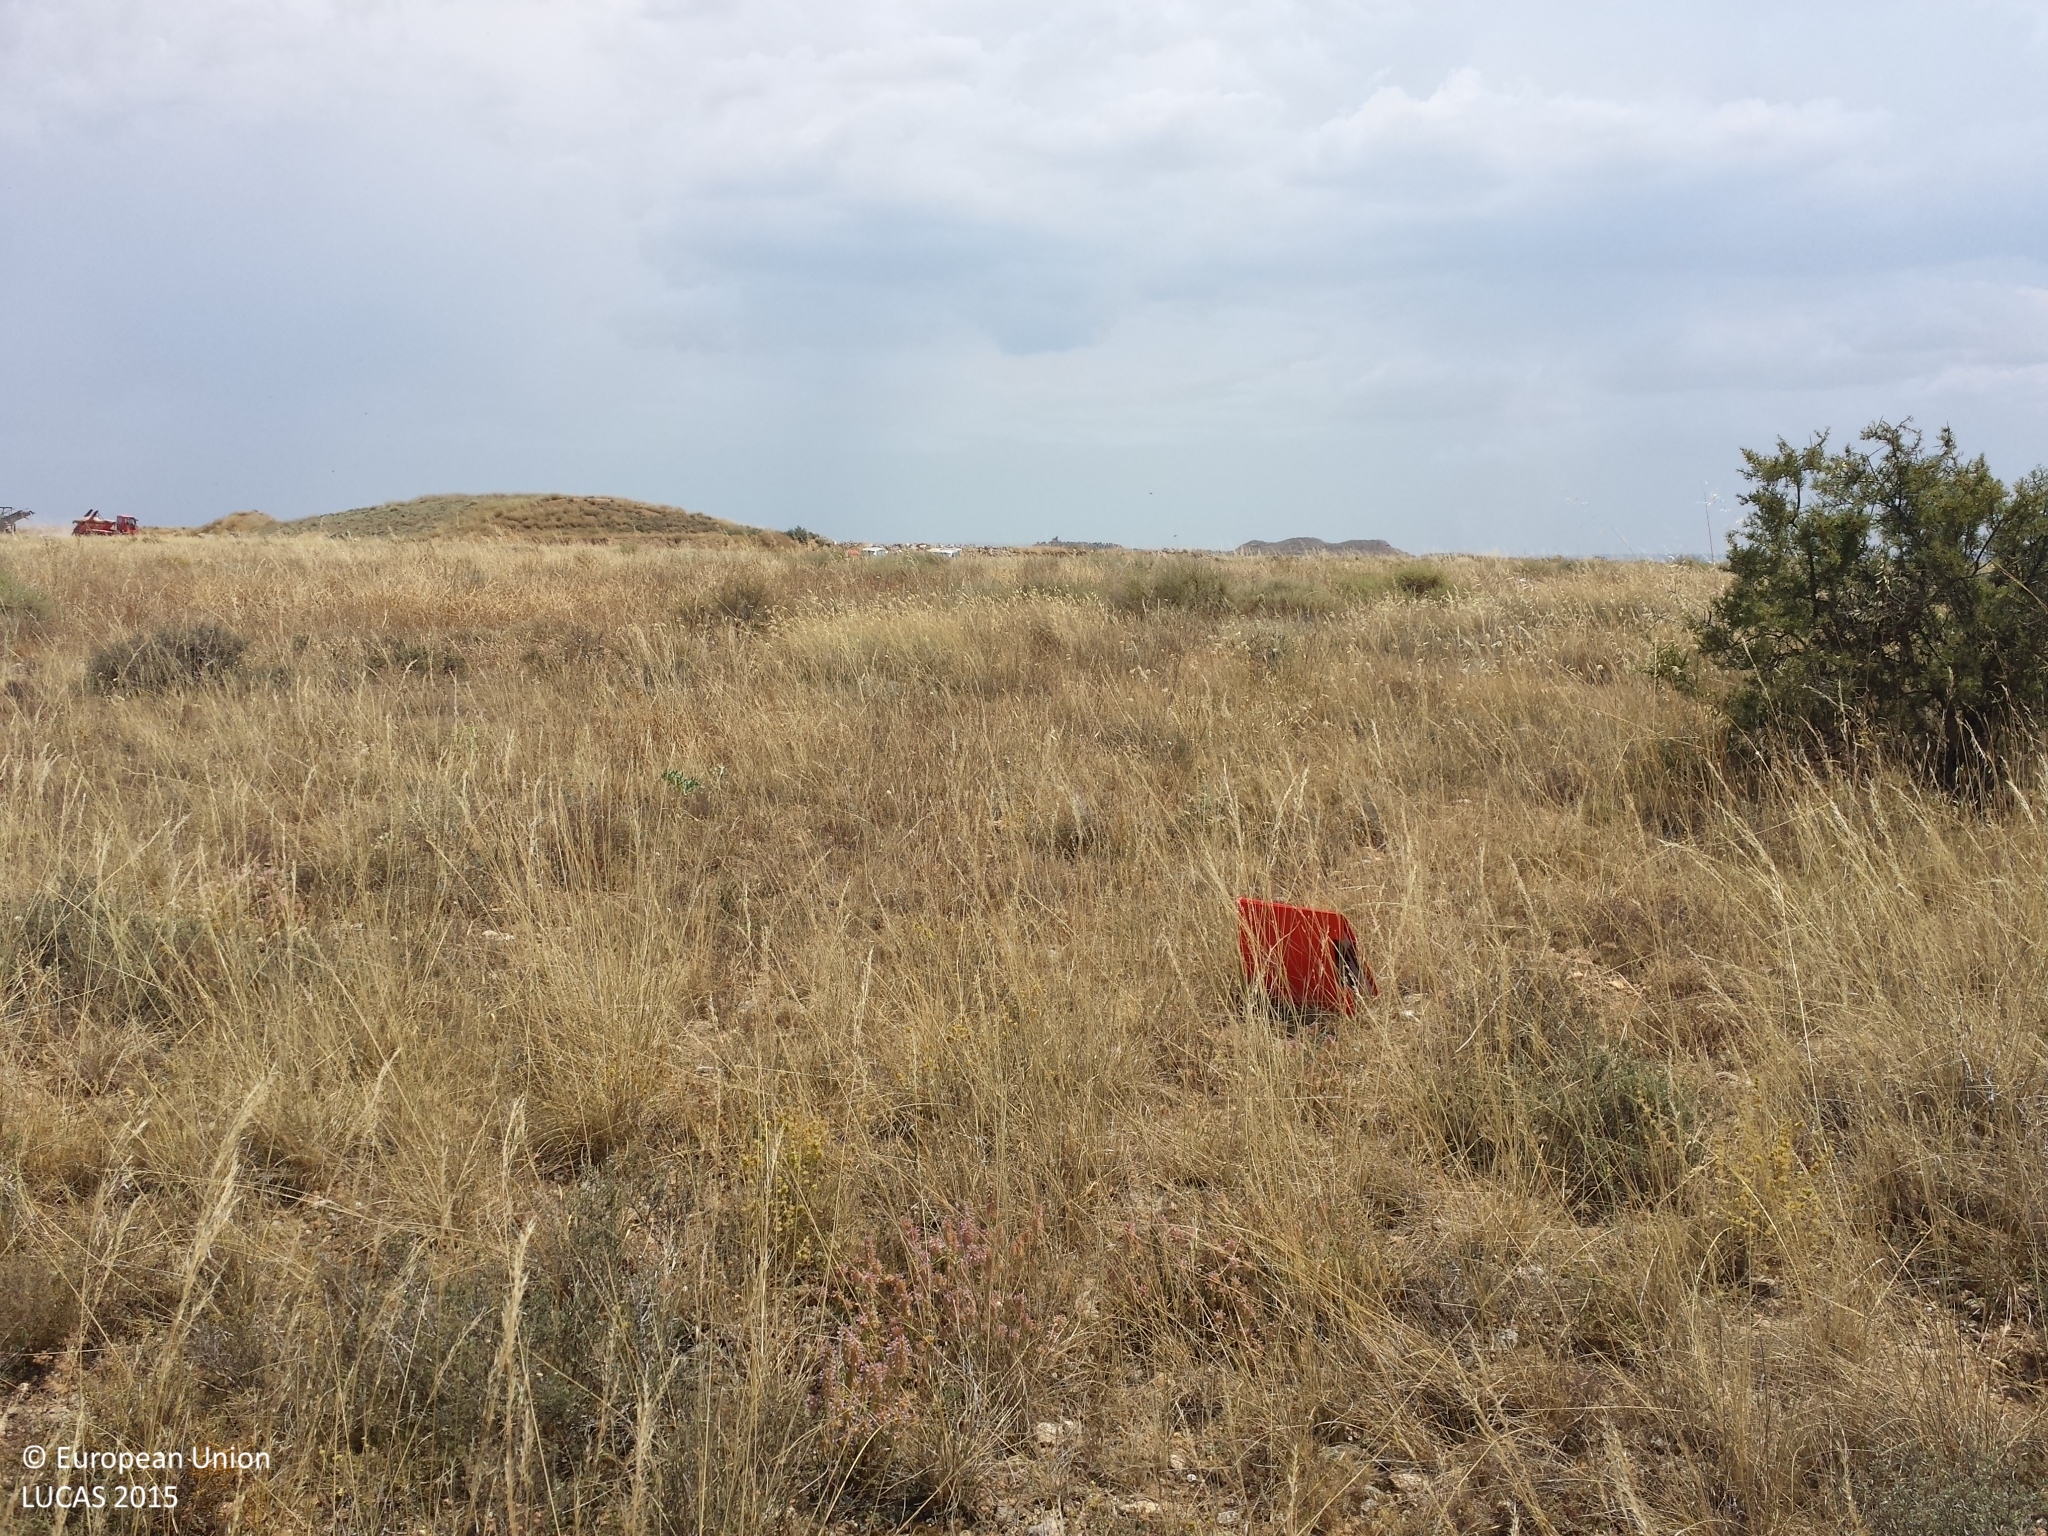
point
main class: Shrubland
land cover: Shrubland without tree cover
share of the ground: > 75 %
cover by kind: shrubs 75 %, herbaceous plants 20 %, consolidated bare surface 5 %
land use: Abandoned areas
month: June
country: ES
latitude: 41.5437
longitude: 0.6019
